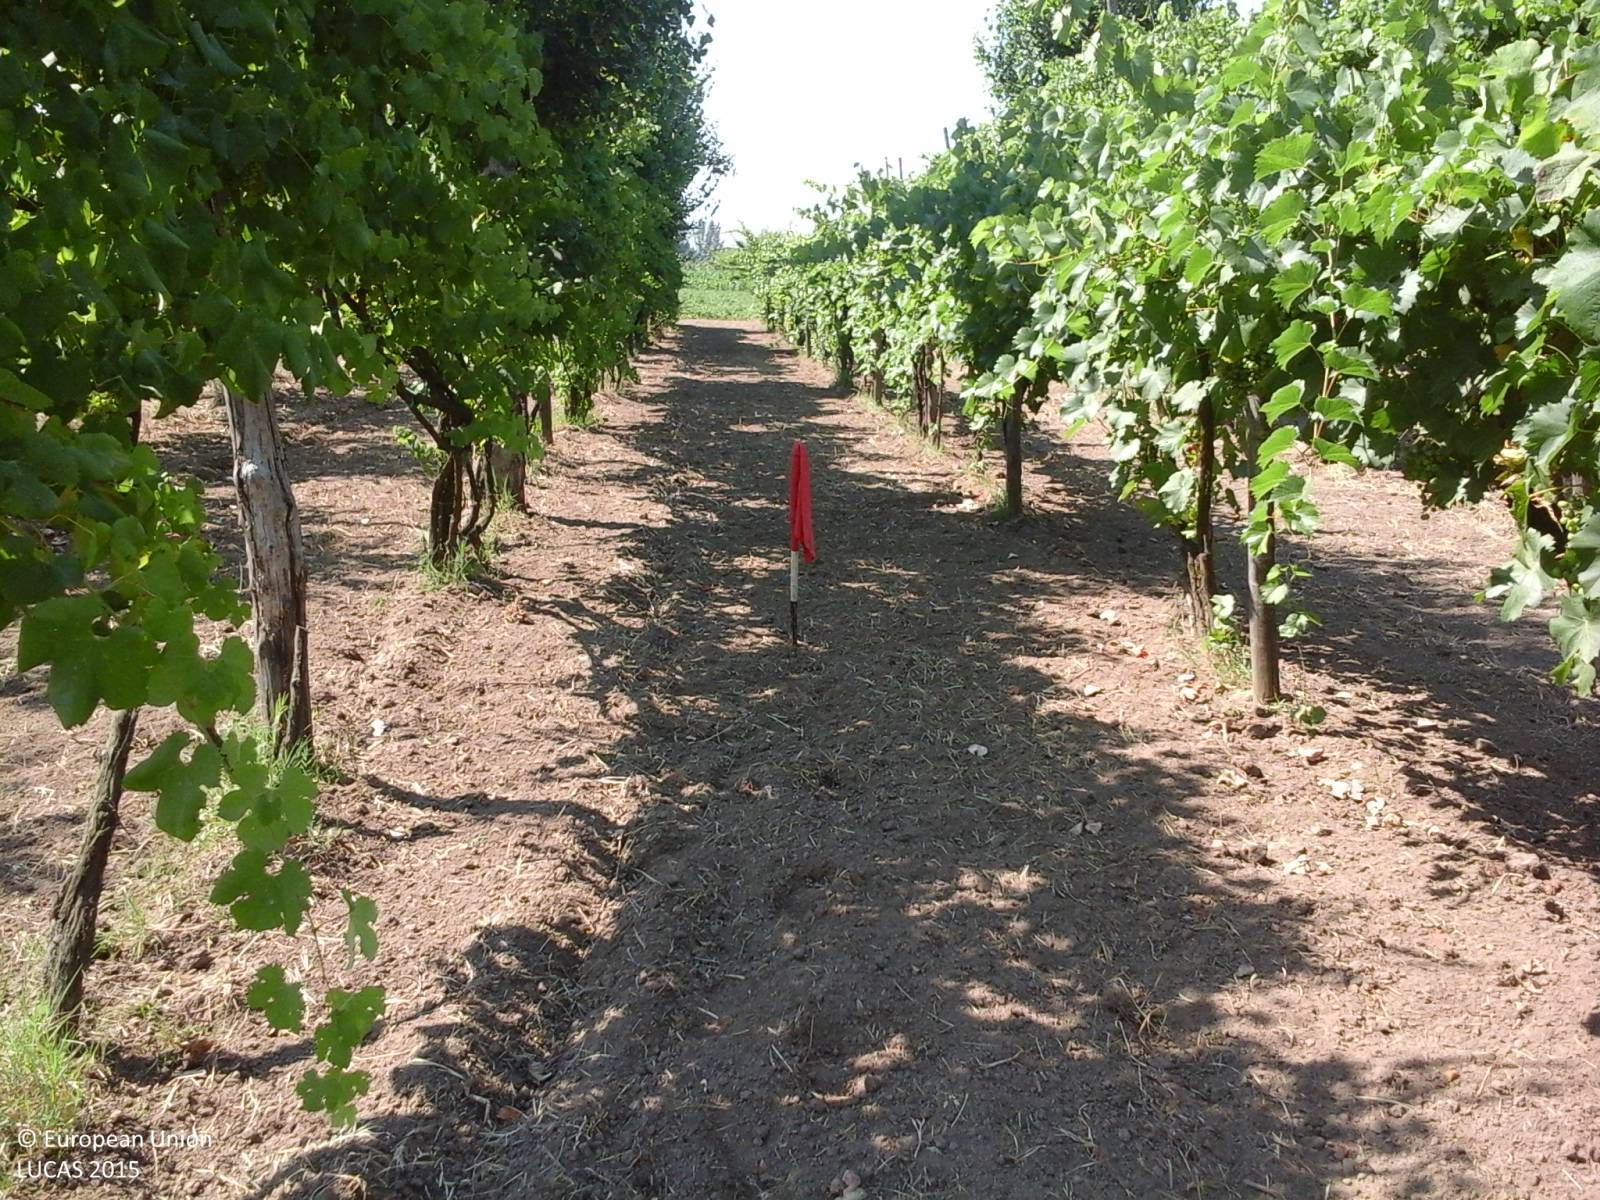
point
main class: Cropland
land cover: Vineyards
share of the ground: 50 - 75 %
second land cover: Other bare soil
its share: > 75 %
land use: Agriculture (excluding fallow land and kitchen gardens)
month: July
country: IT
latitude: 41.0106
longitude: 14.2040
